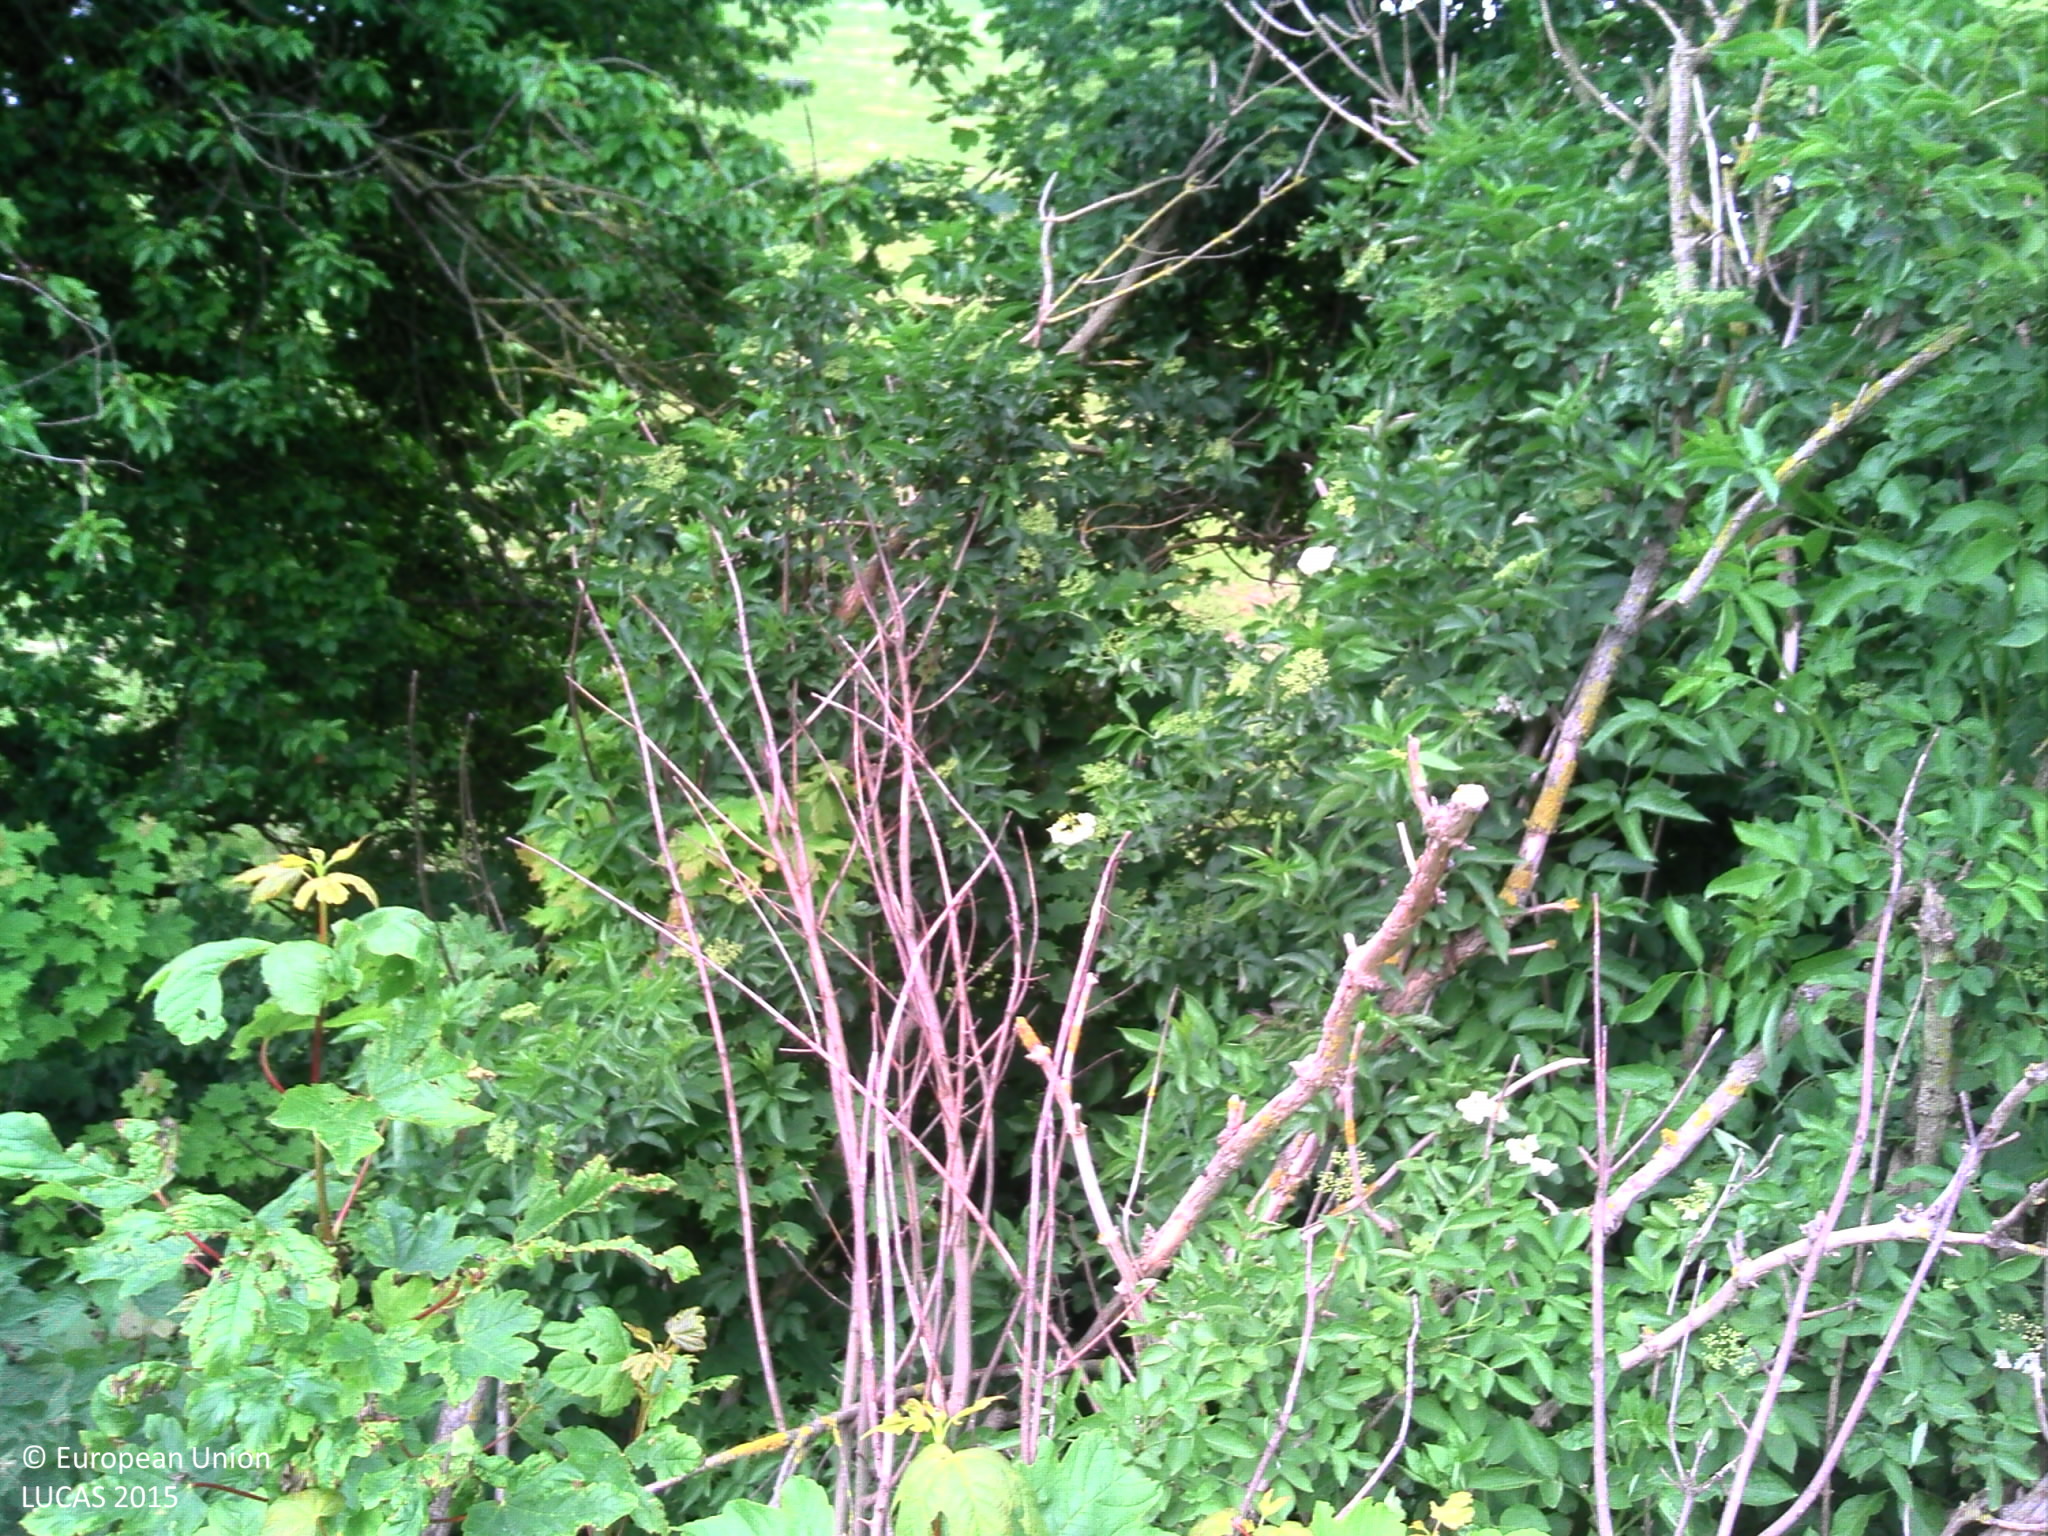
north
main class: Woodland
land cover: Broadleaved woodland
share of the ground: > 75 %
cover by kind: broadleaved forest trees 100 %
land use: Amenities, museums, leisure
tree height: > 5 m
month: May
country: BE
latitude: 50.6778
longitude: 4.4056
